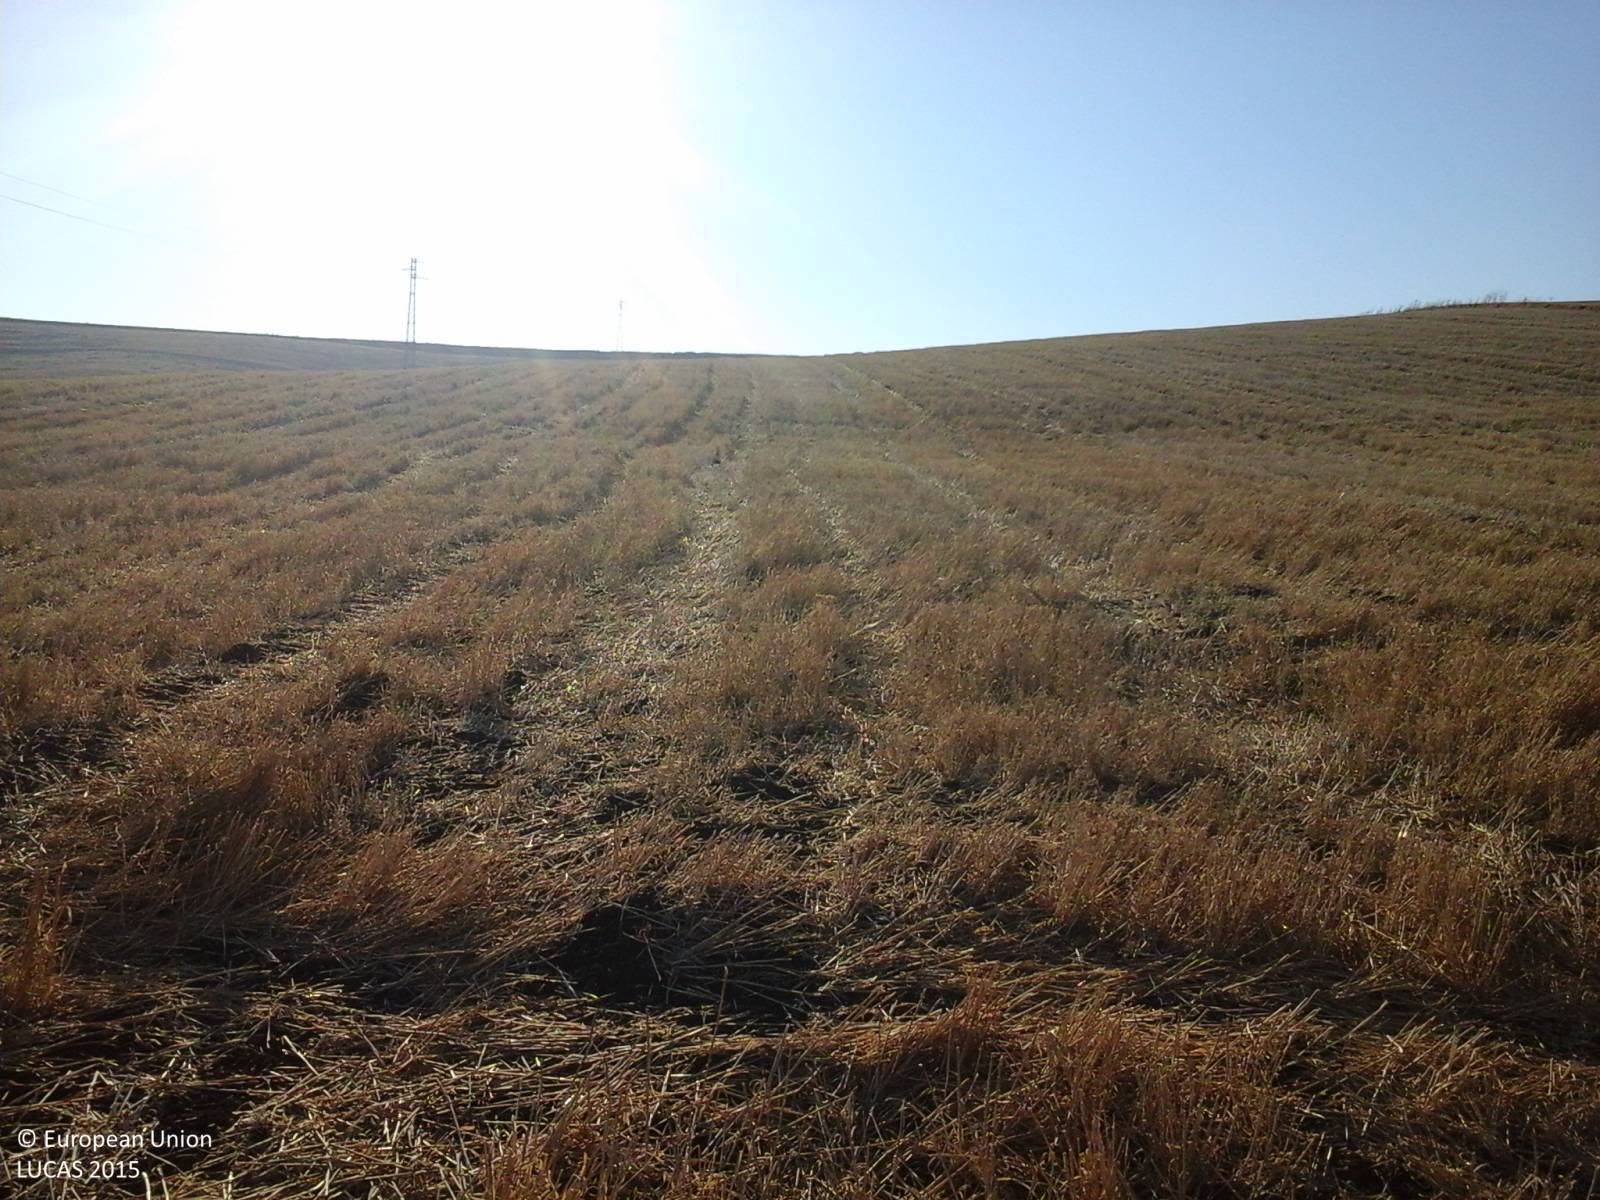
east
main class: Cropland
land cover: Durum wheat
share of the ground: > 75 %
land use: Agriculture (excluding fallow land and kitchen gardens)
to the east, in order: Durum wheat; Other leguminous and mixtures for fodder
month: July
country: IT
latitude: 37.8800
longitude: 13.0588
